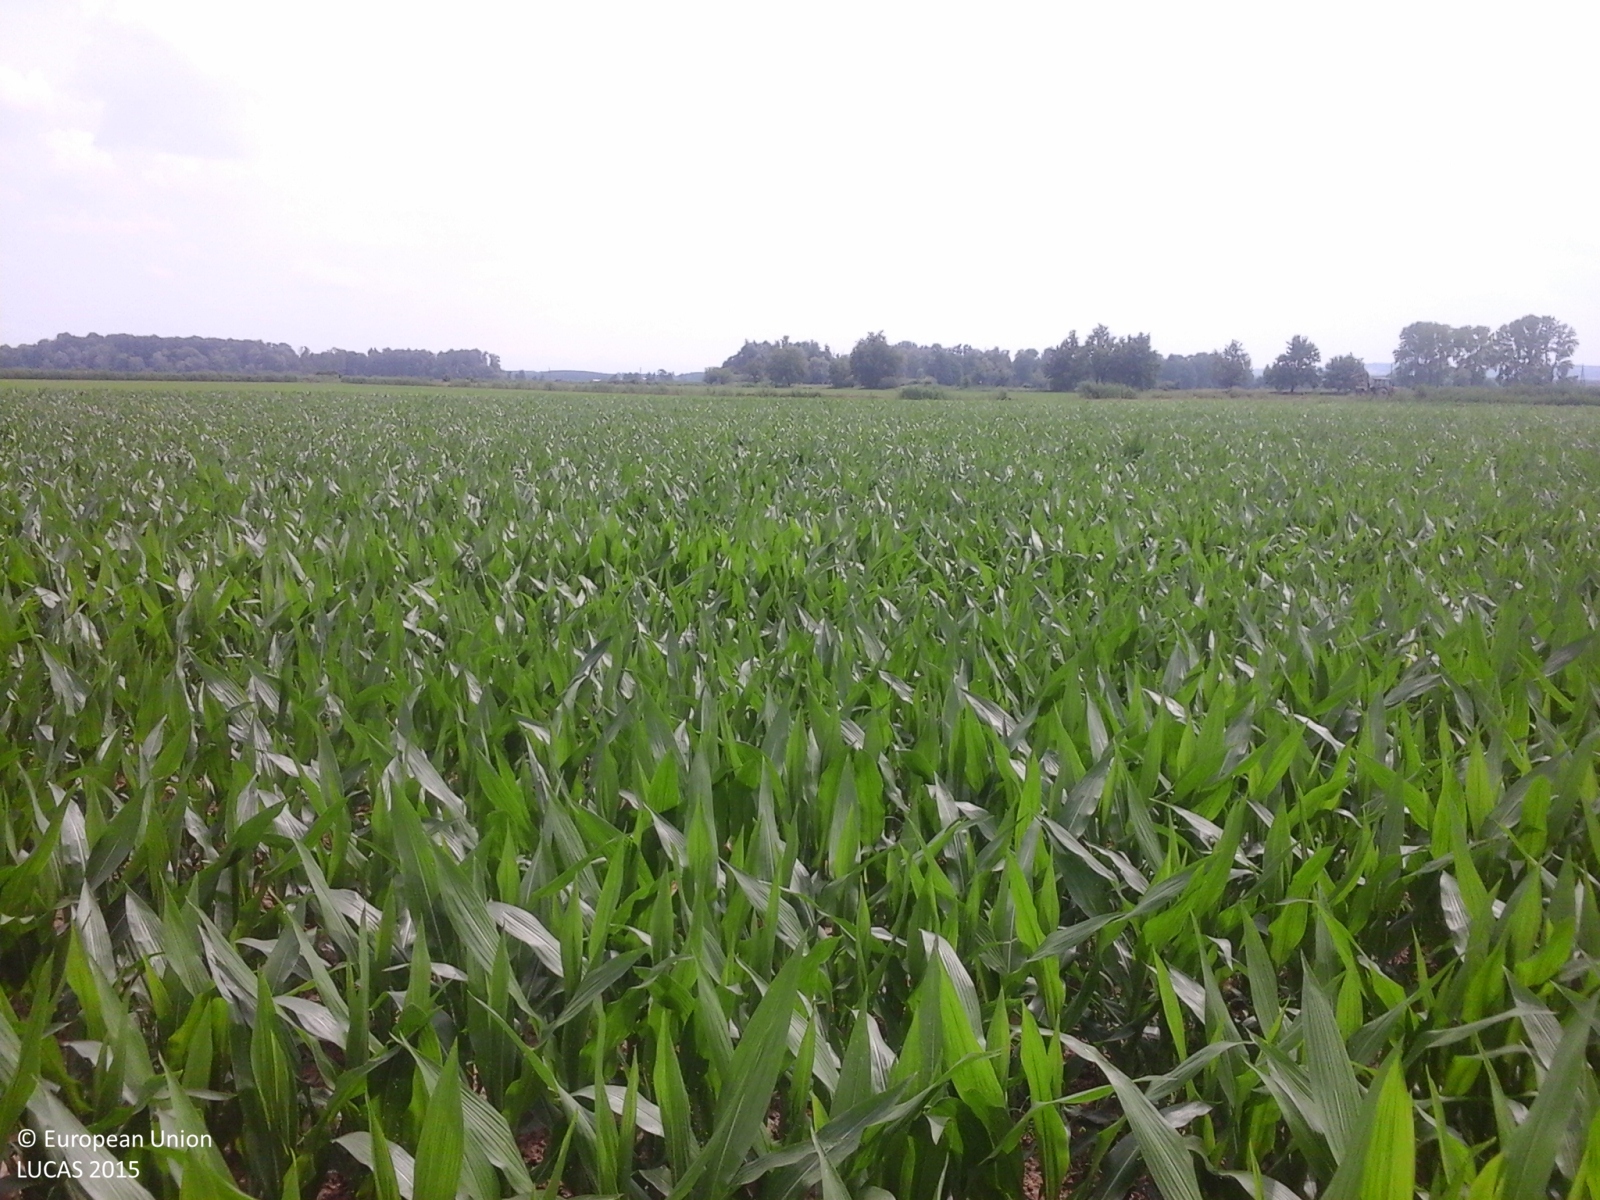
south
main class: Cropland
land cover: Maize
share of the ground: > 75 %
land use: Agriculture (excluding fallow land and kitchen gardens)
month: June
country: IT
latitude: 45.0640
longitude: 8.7197
